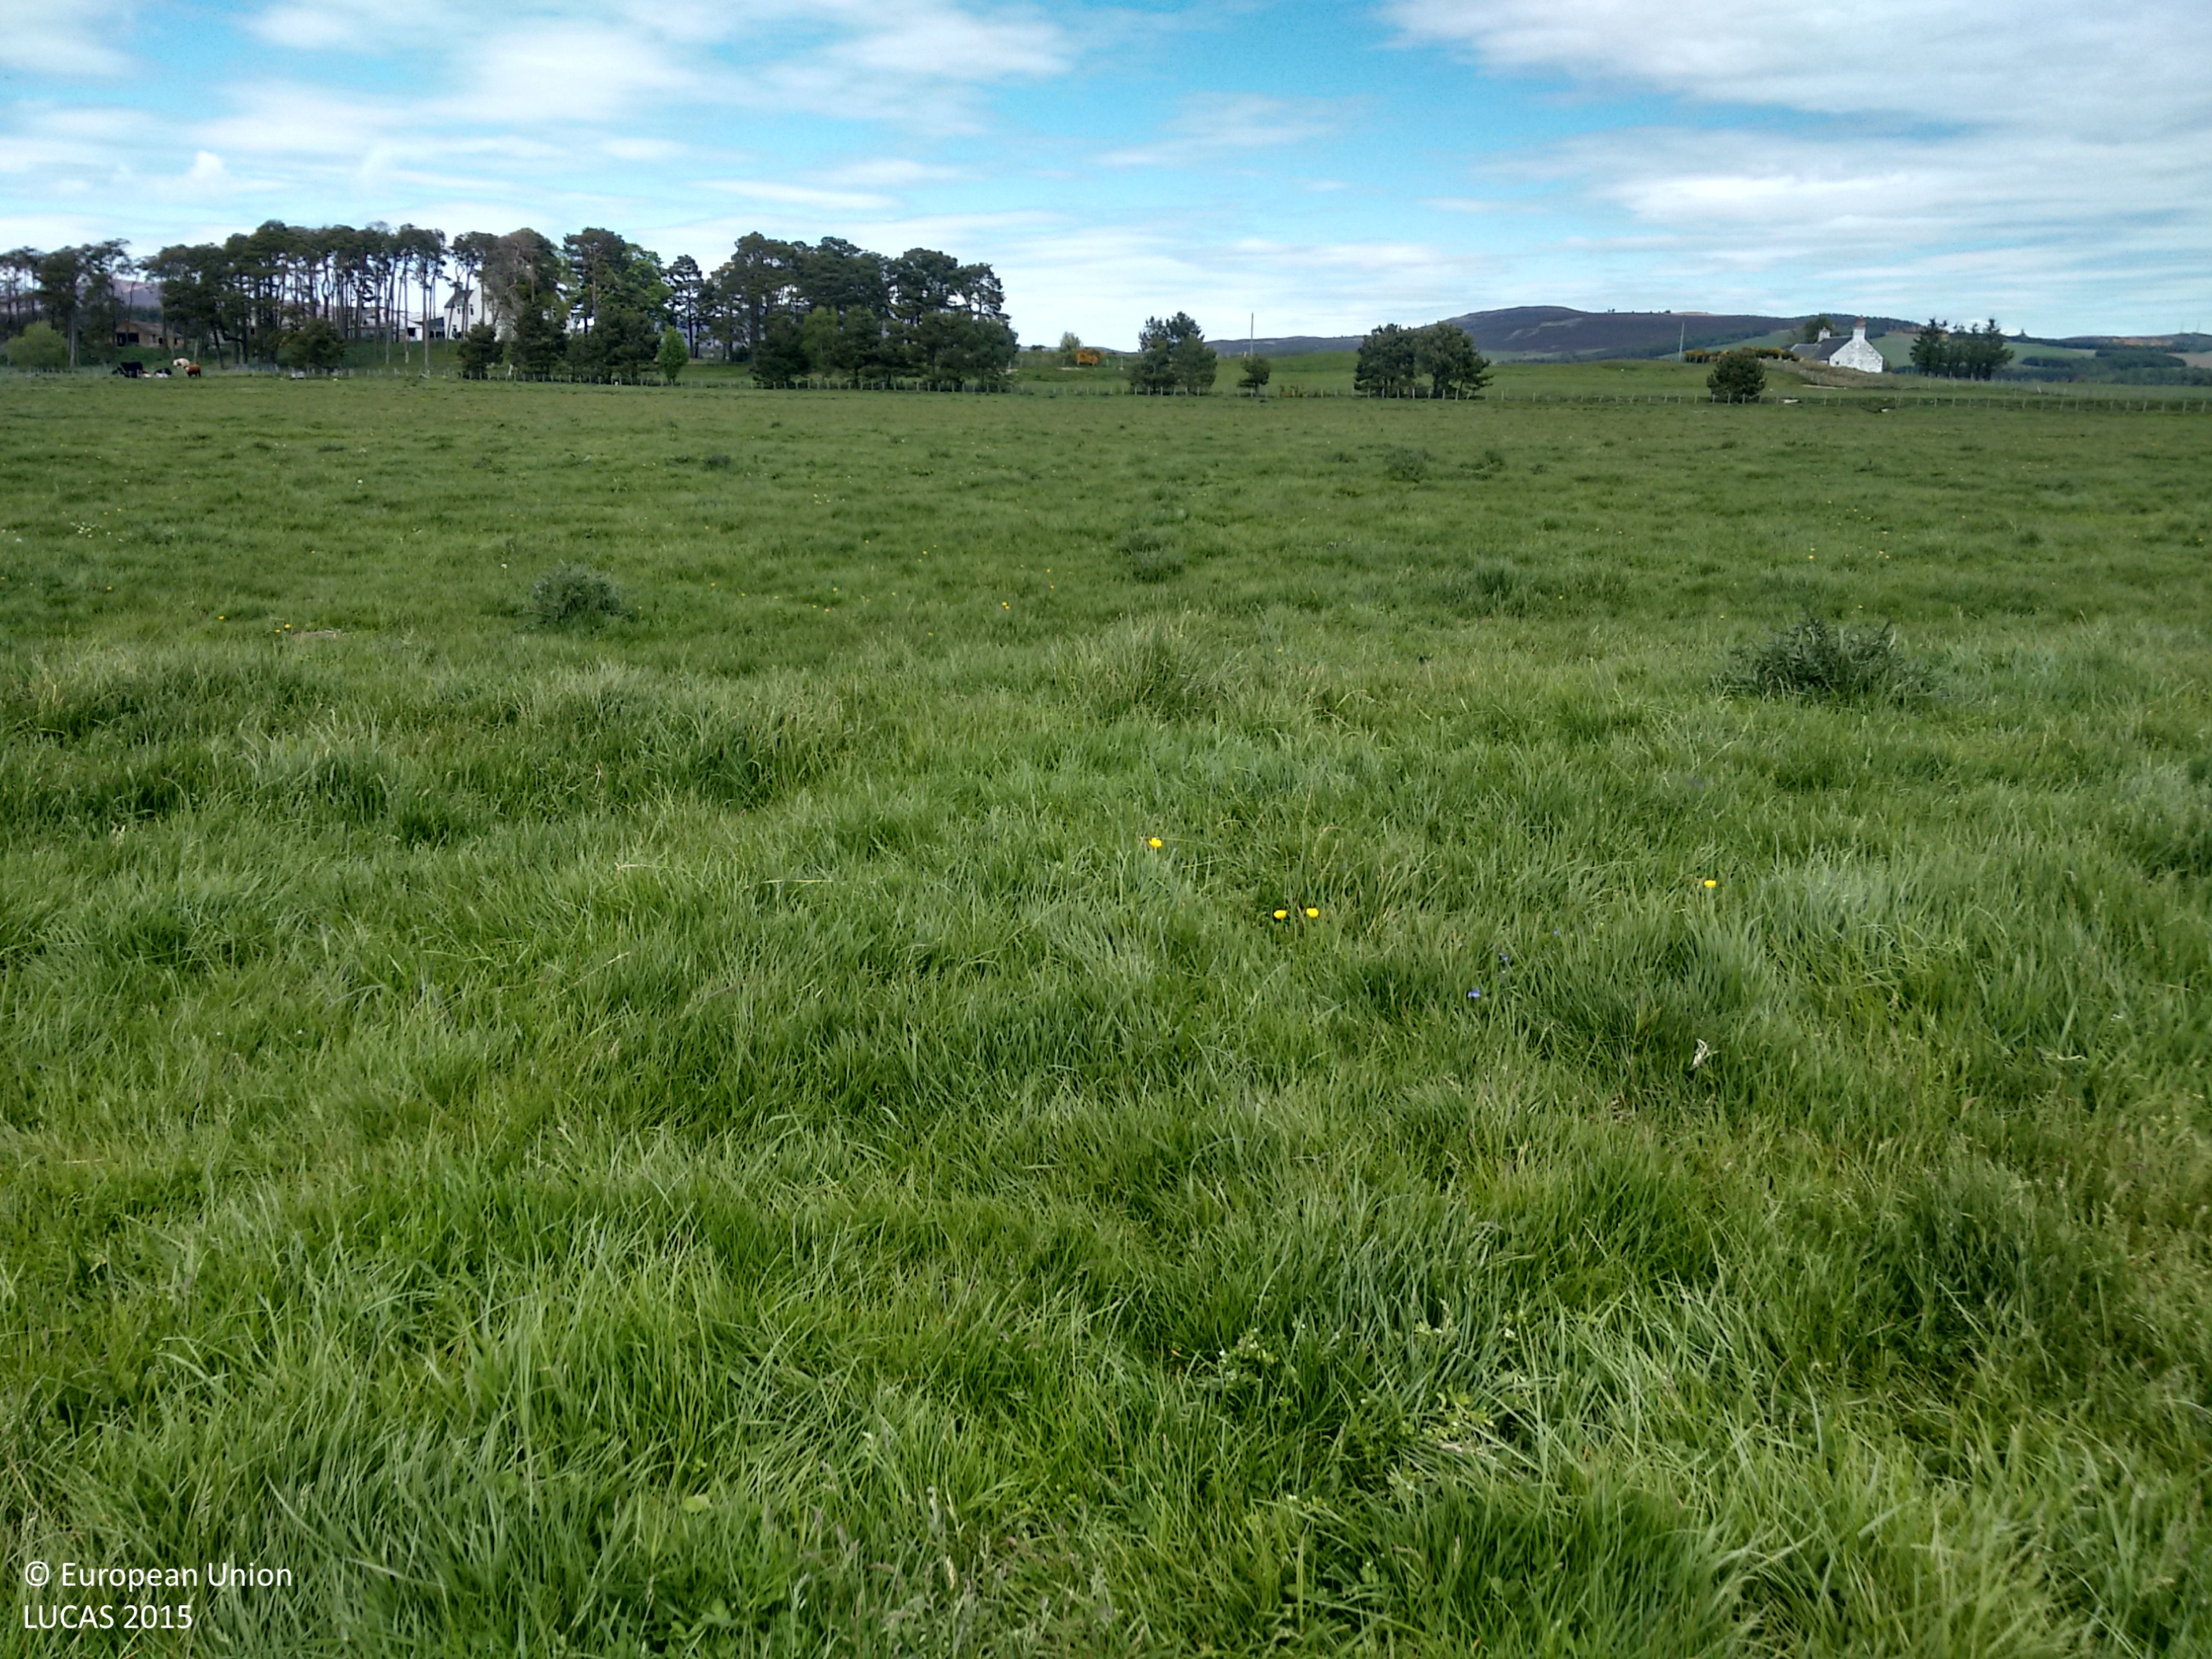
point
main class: Grassland
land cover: Grassland without tree/shrub cover
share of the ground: > 75 %
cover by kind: herbaceous plants 100 %
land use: Agriculture (excluding fallow land and kitchen gardens)
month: June
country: GB
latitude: 57.2906
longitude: -3.7314
